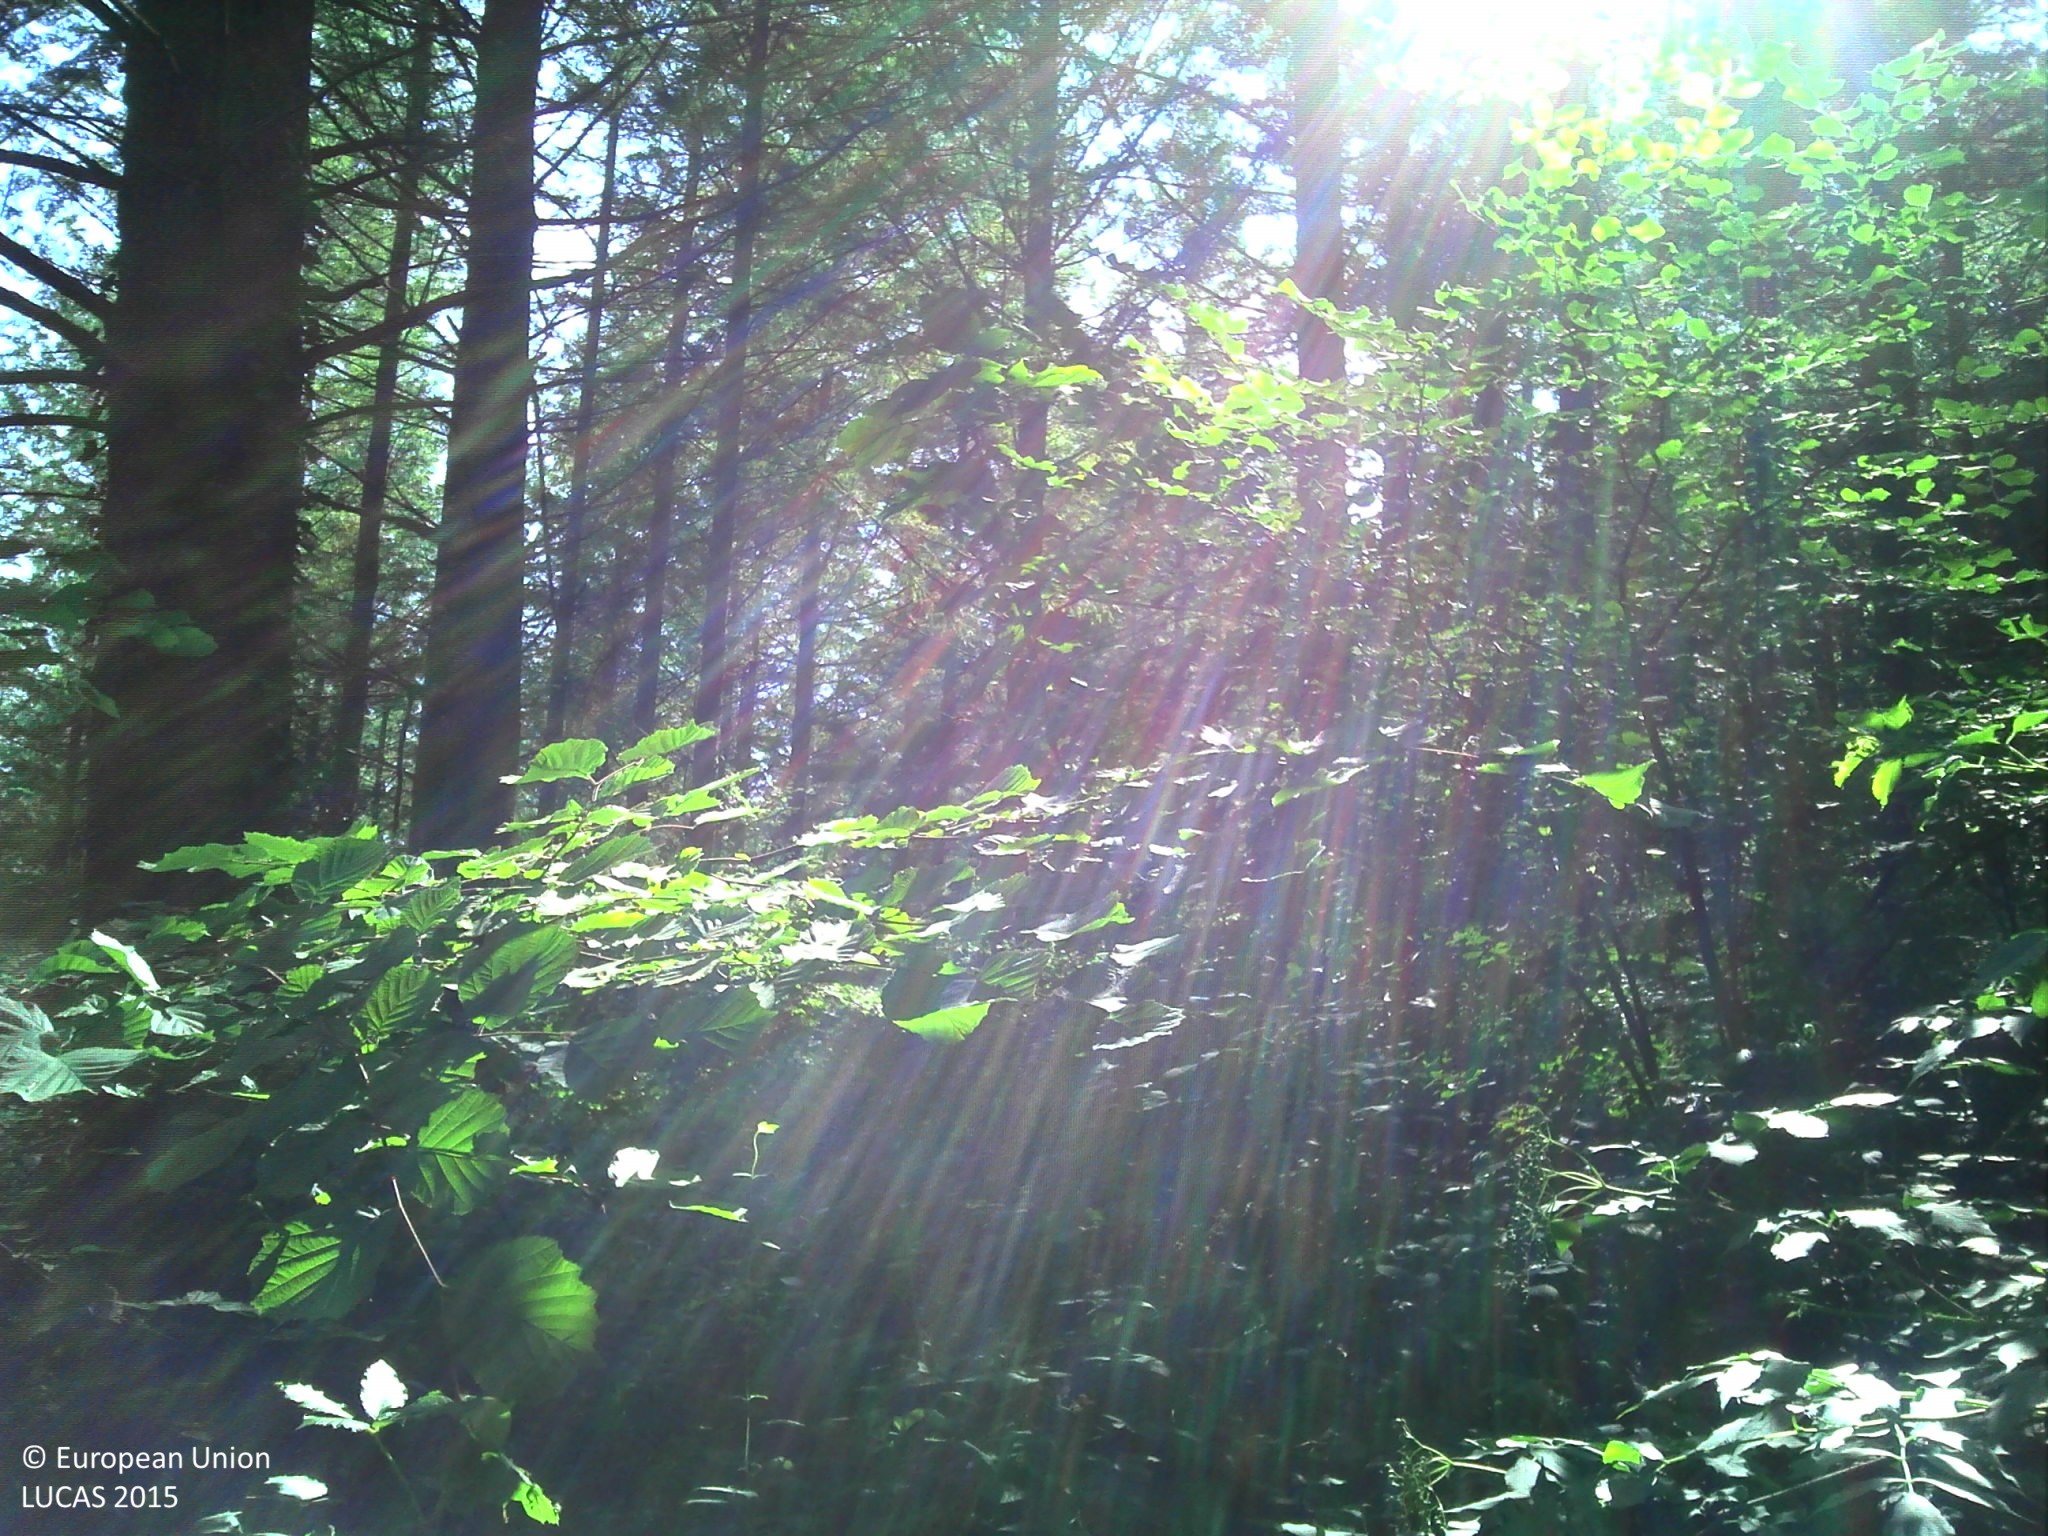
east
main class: Woodland
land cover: Spruce dominated coniferous woodland
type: exotic forest
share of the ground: > 75 %
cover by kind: coniferous forest trees 80 %, shrubs 10 %, herbaceous plants 10 %
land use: Forestry
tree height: > 5 m
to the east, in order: Spruce dominated coniferous woodland; Tracks; Spruce dominated coniferous woodland; Rivers and streams; Broadleaved woodland; Tracks; Broadleaved woodland
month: July
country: FR
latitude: 45.6017
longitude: 1.8024
